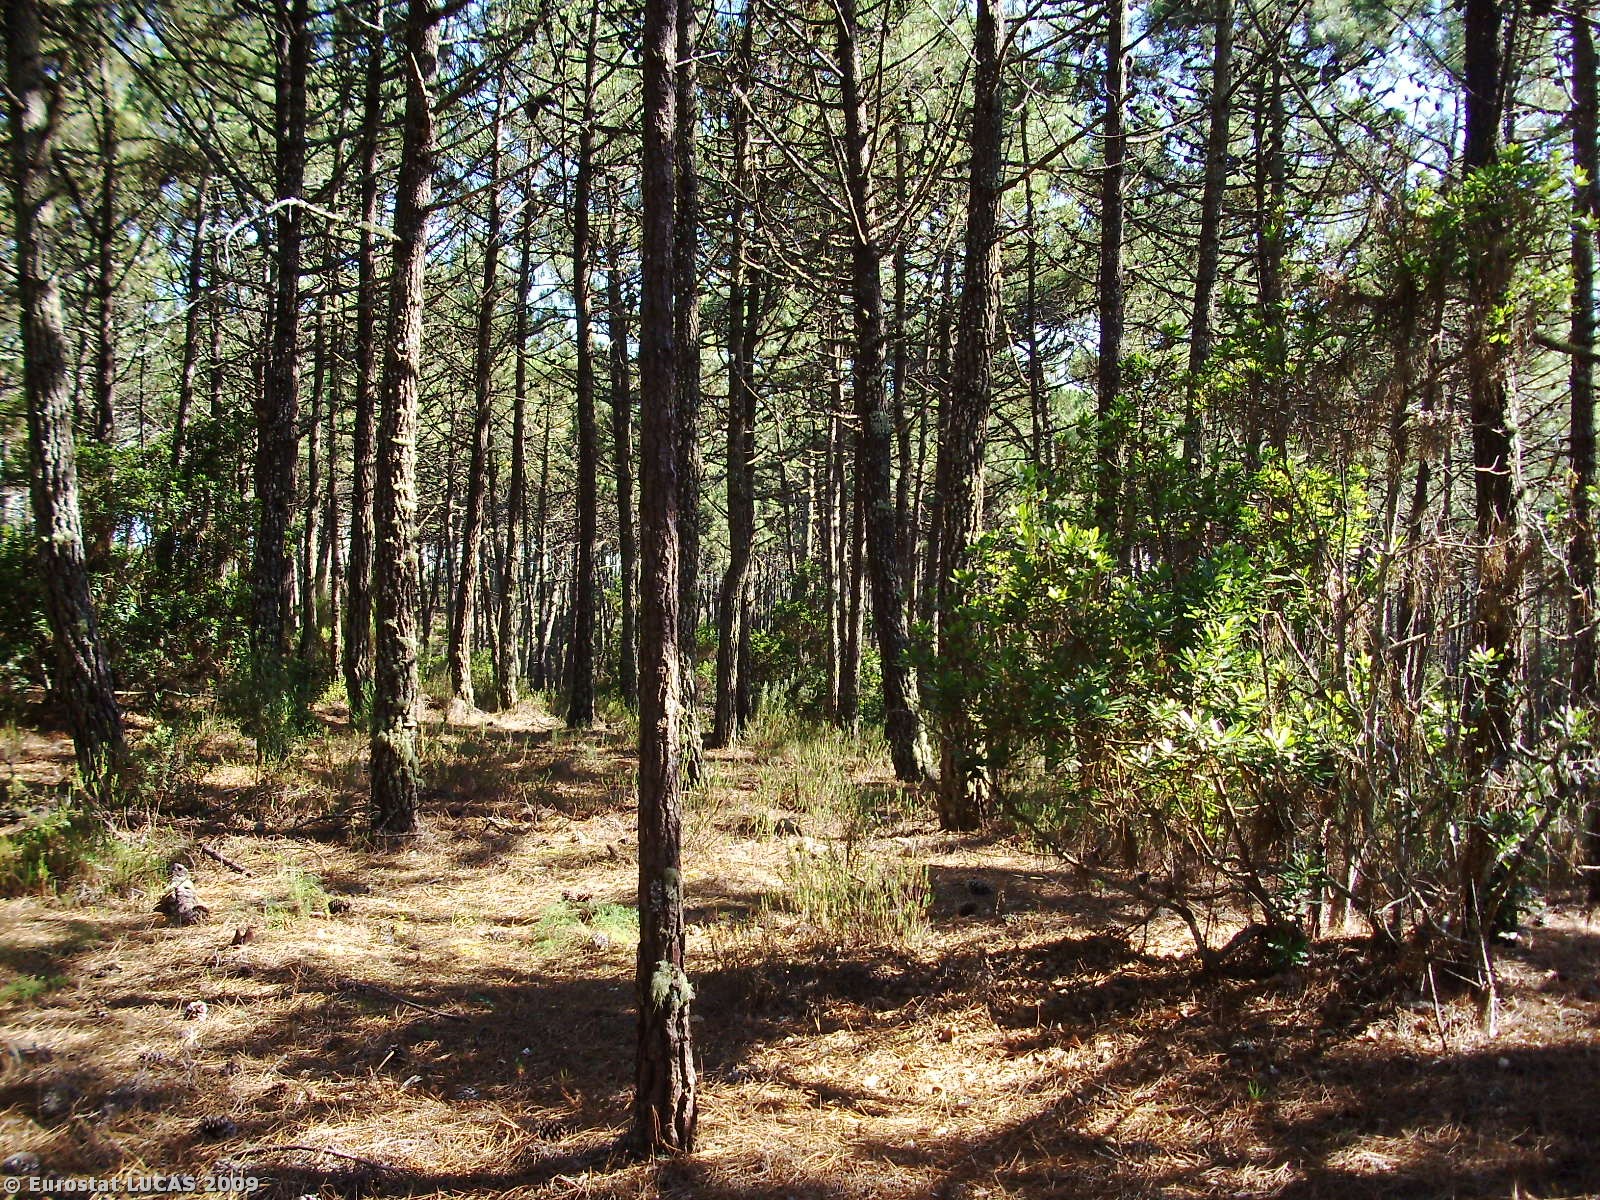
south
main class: Woodland
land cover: Coniferous woodland
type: coniferous forest of the mediterranean region
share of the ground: > 75 %
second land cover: Shrubland with sparse tree cover
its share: 10 - 25 %
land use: Forestry
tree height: > 5 m
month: August
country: PT
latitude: 39.9042
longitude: -8.9364
